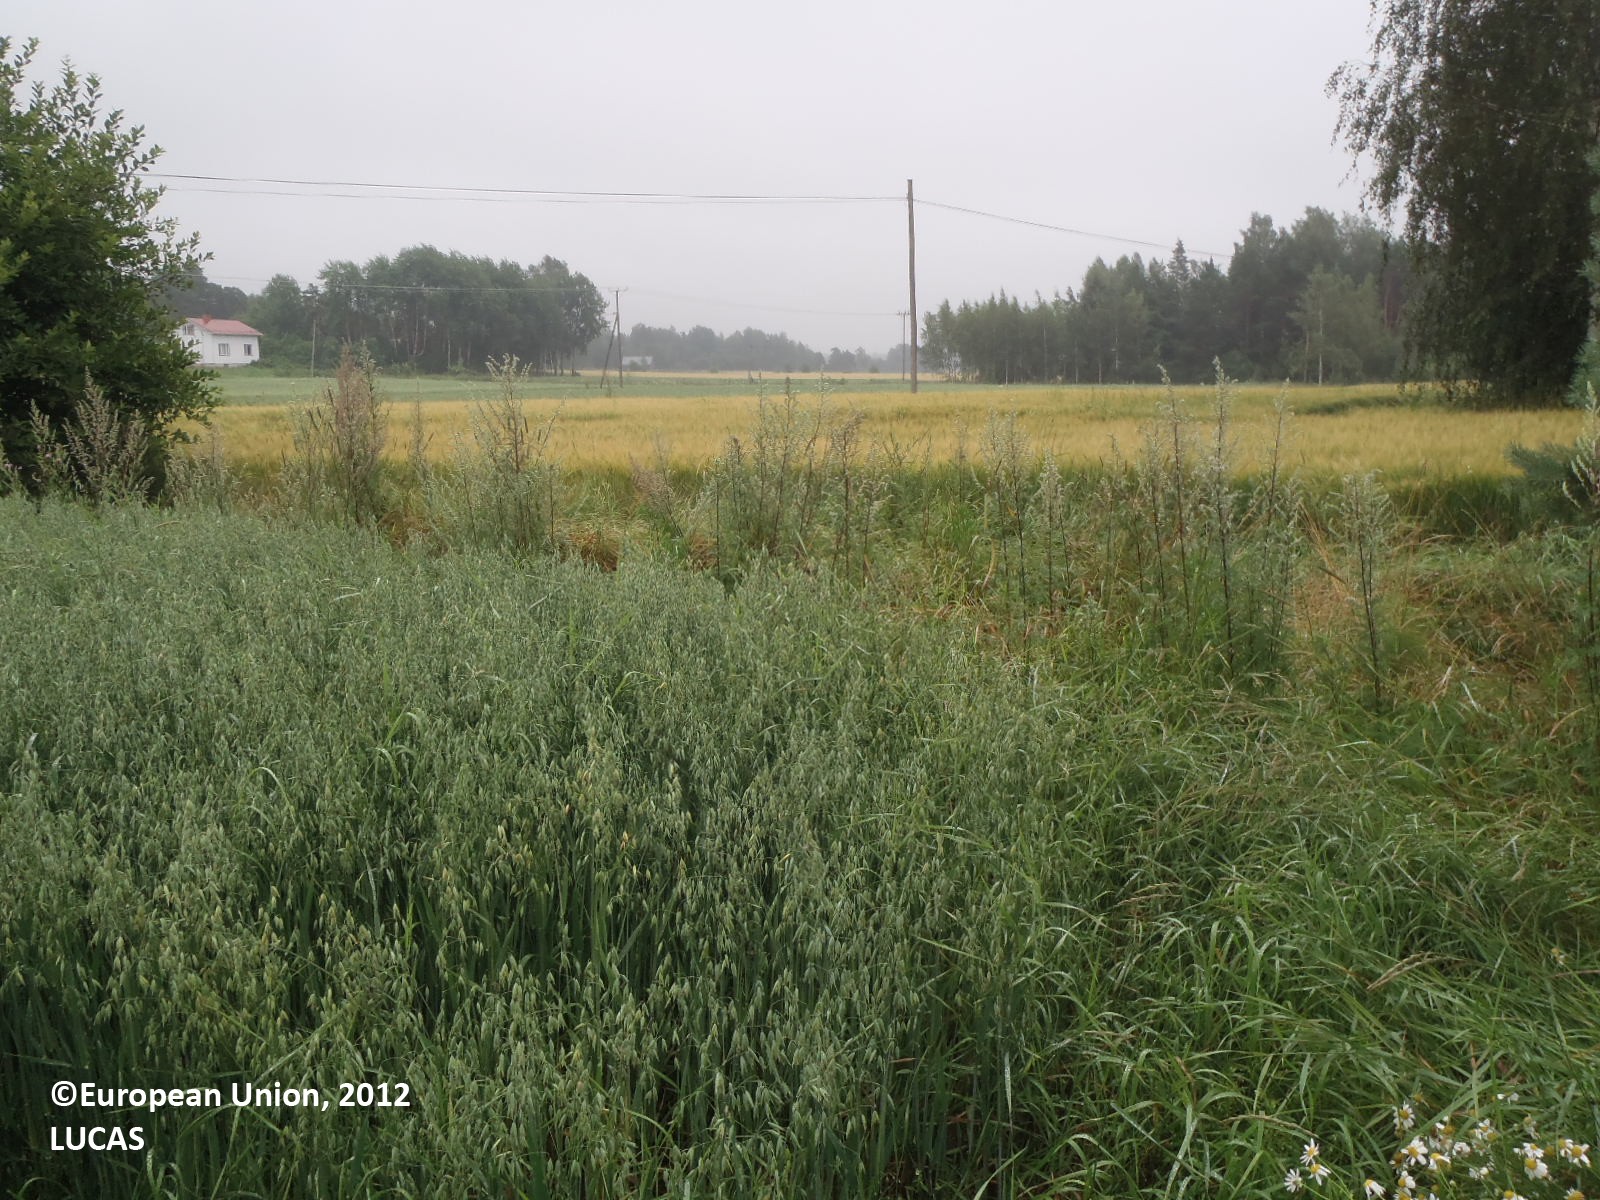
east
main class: Cropland
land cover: Oats
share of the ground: > 75 %
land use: Agriculture (excluding fallow land and kitchen gardens)
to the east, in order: Oats; Grass margins; Abandoned hedges; Ditches and canals; Grass margins; Barley; Grass margins; Ditches and canals; Grass margins; Barley; Ditches and canals; Grass margins; Oats; Electric lines; Oats; Grassland with sparse tree/shrub cover; Floriculture and ornamental plants; Grassland with sparse tree/shrub cover; Paved roads, cycling and walking lanes; Grass margins; Ditches and canals; Grass margins; Pine dominated mixed woodland; Ditches and canals; Grass margins; Barley
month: July
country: FI
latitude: 60.6896
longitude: 21.7605
